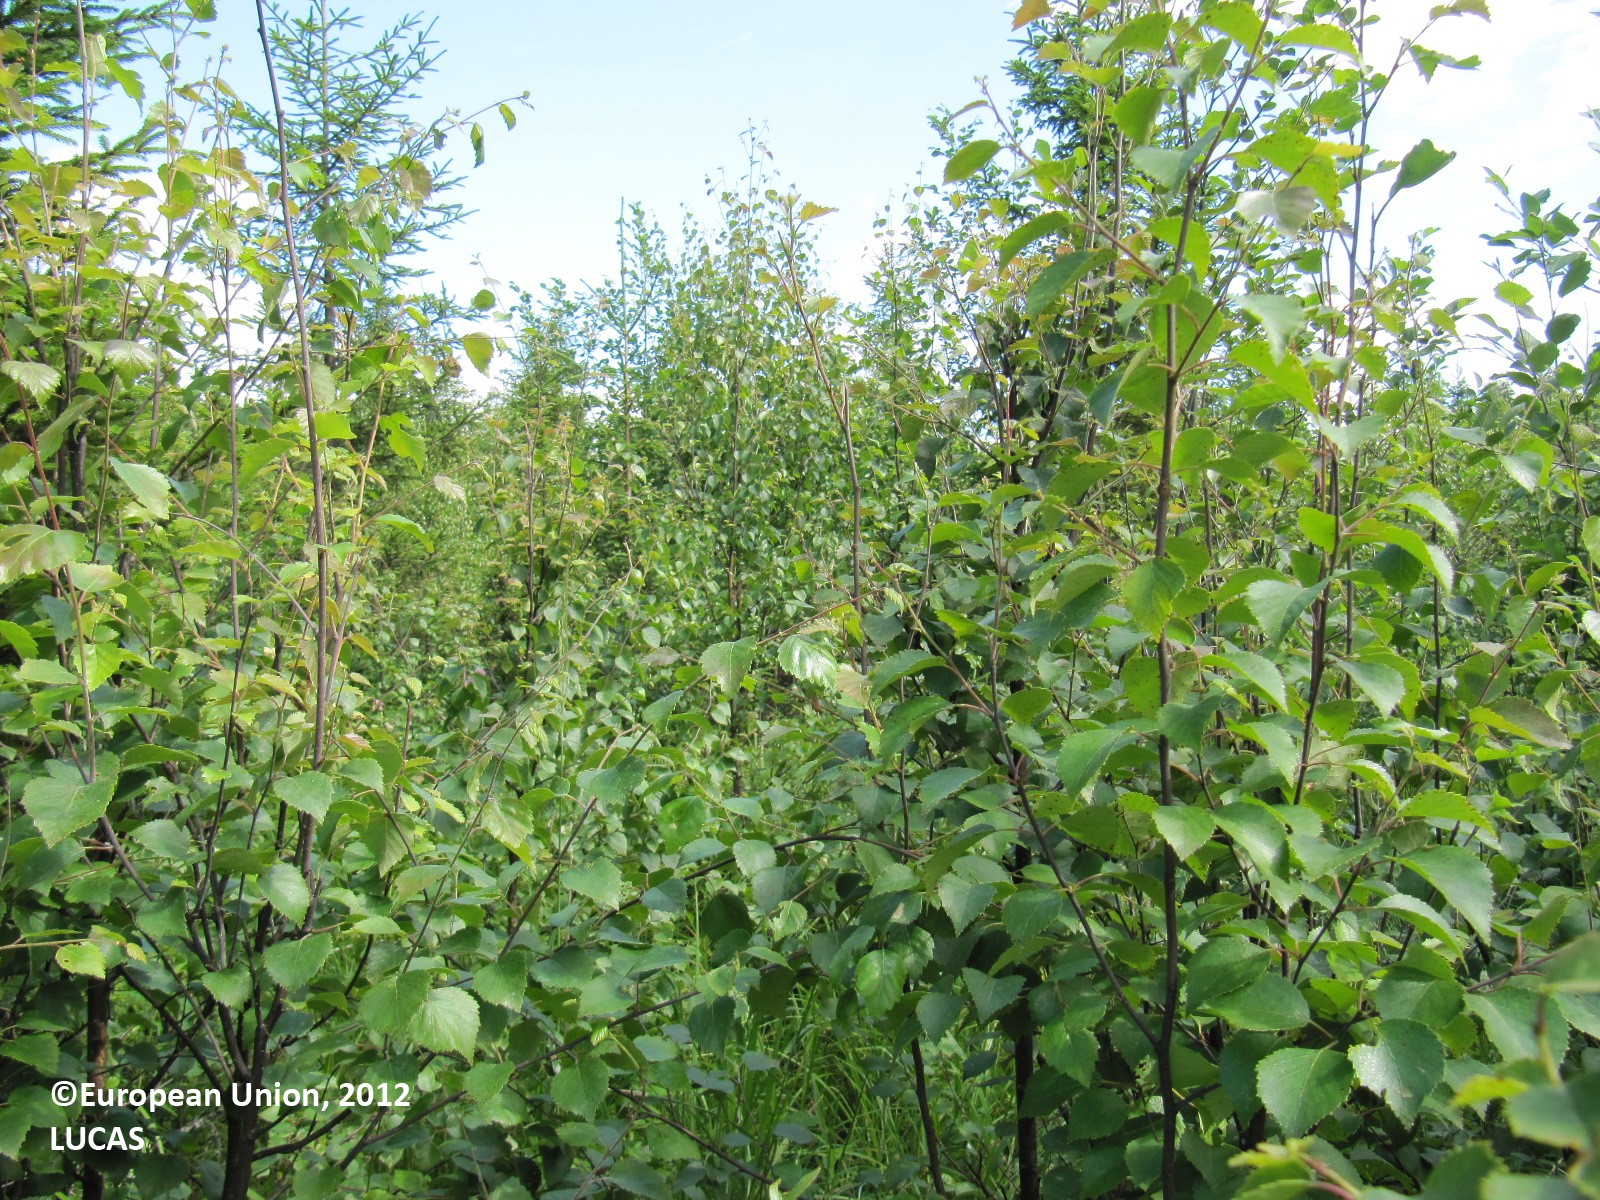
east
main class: Woodland
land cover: Broadleaved woodland
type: boreal forest
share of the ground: > 75 %
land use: Forestry
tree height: < 5 m
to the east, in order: Broadleaved woodland; Other mixed woodland; Grassland with sparse tree/shrub cover
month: July
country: FI
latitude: 60.9800
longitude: 24.1961
